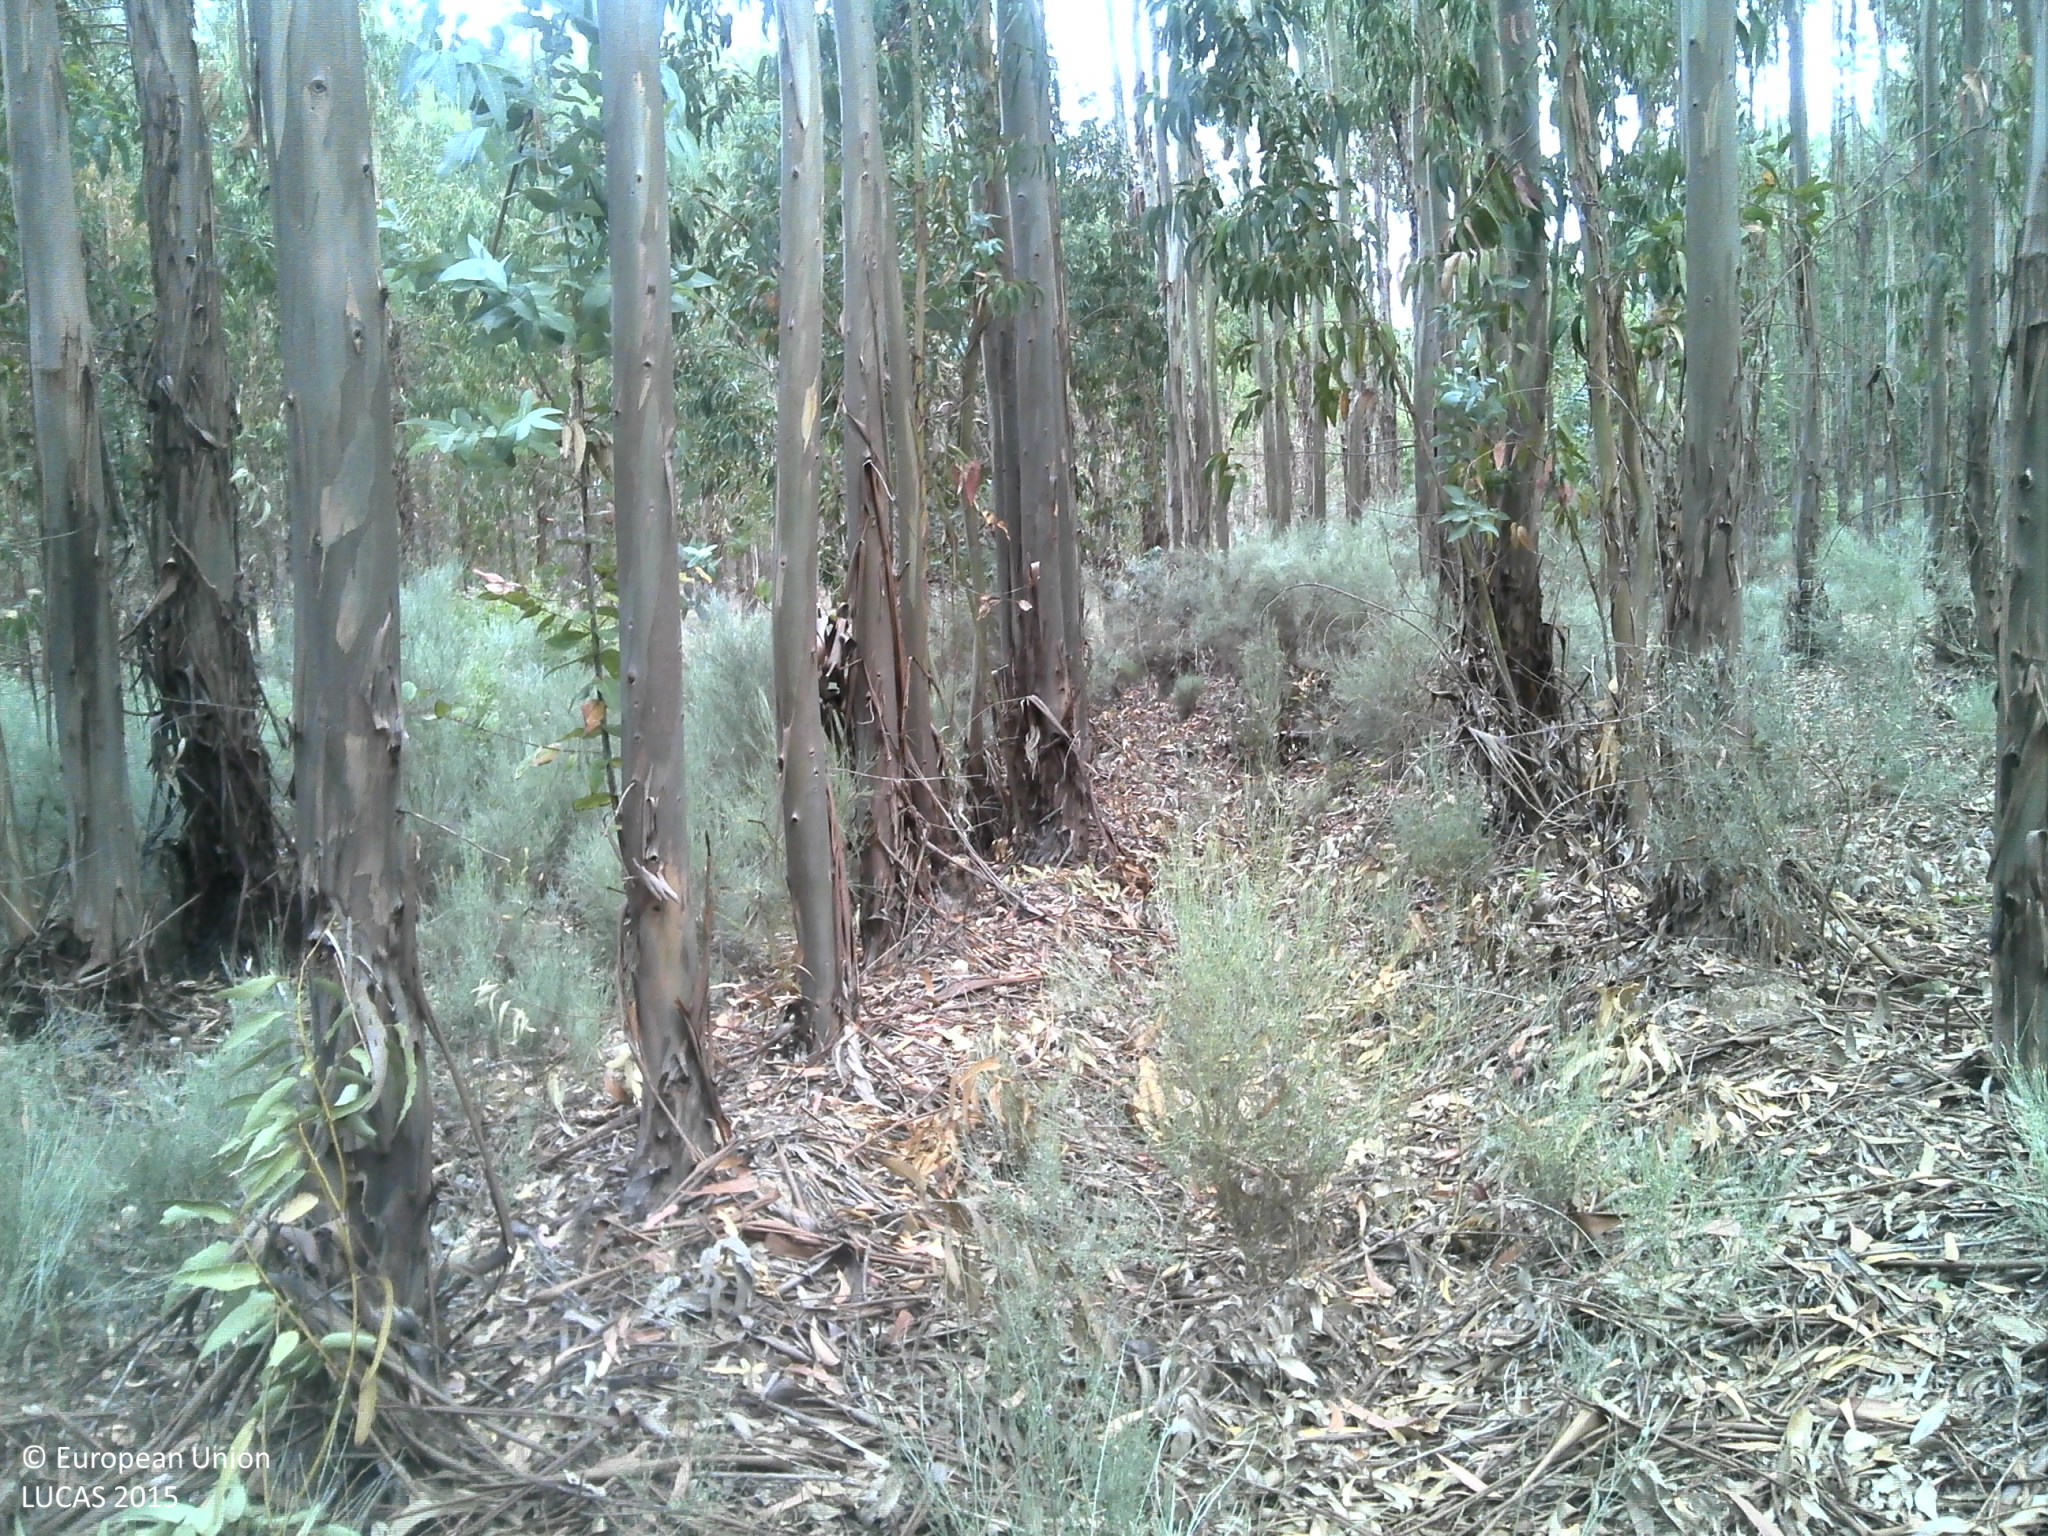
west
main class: Woodland
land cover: Broadleaved woodland
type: exotic forest
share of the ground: 50 - 75 %
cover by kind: broadleaved forest trees 60 %, shrubs 20 %, unconsolidated bare surface 20 %
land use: Forestry
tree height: > 5 m
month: June
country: PT
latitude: 40.2402
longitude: -7.3467
